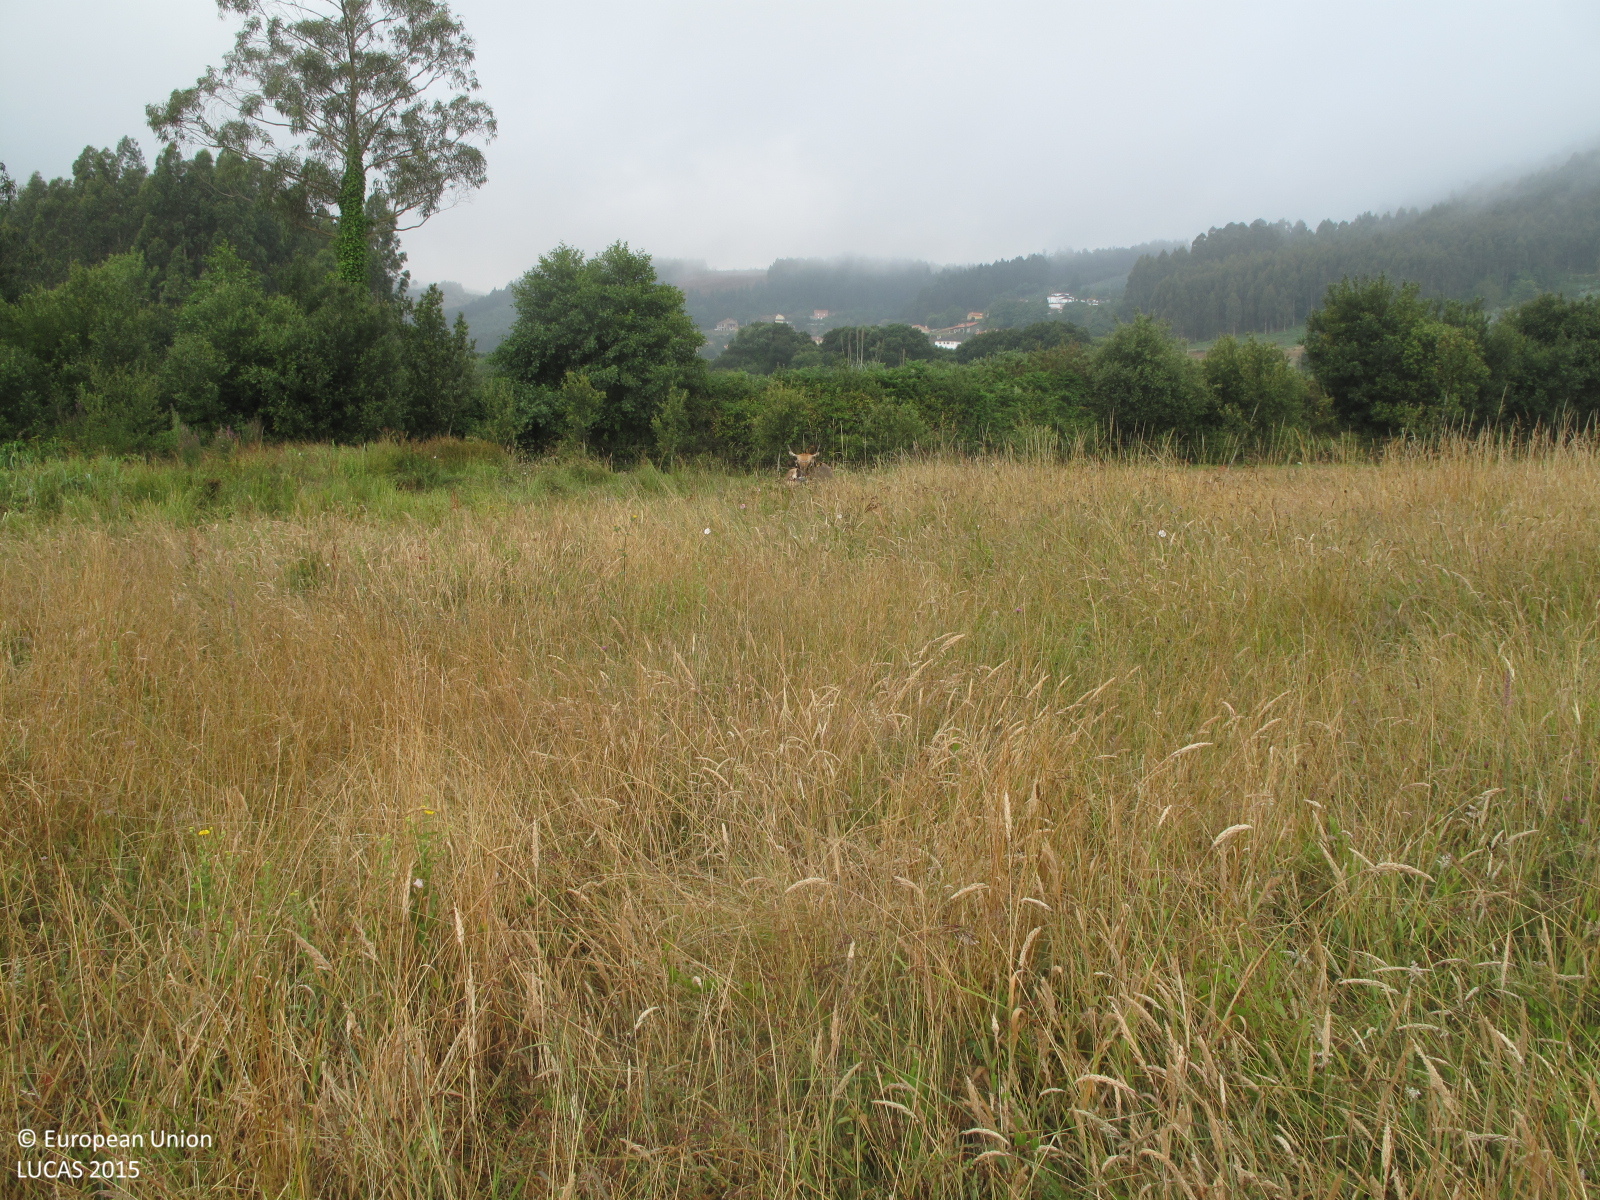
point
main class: Grassland
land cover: Grassland without tree/shrub cover
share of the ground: > 75 %
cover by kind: herbaceous plants 100 %
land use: Agriculture (excluding fallow land and kitchen gardens)
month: July
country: ES
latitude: 43.5307
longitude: -8.2310
